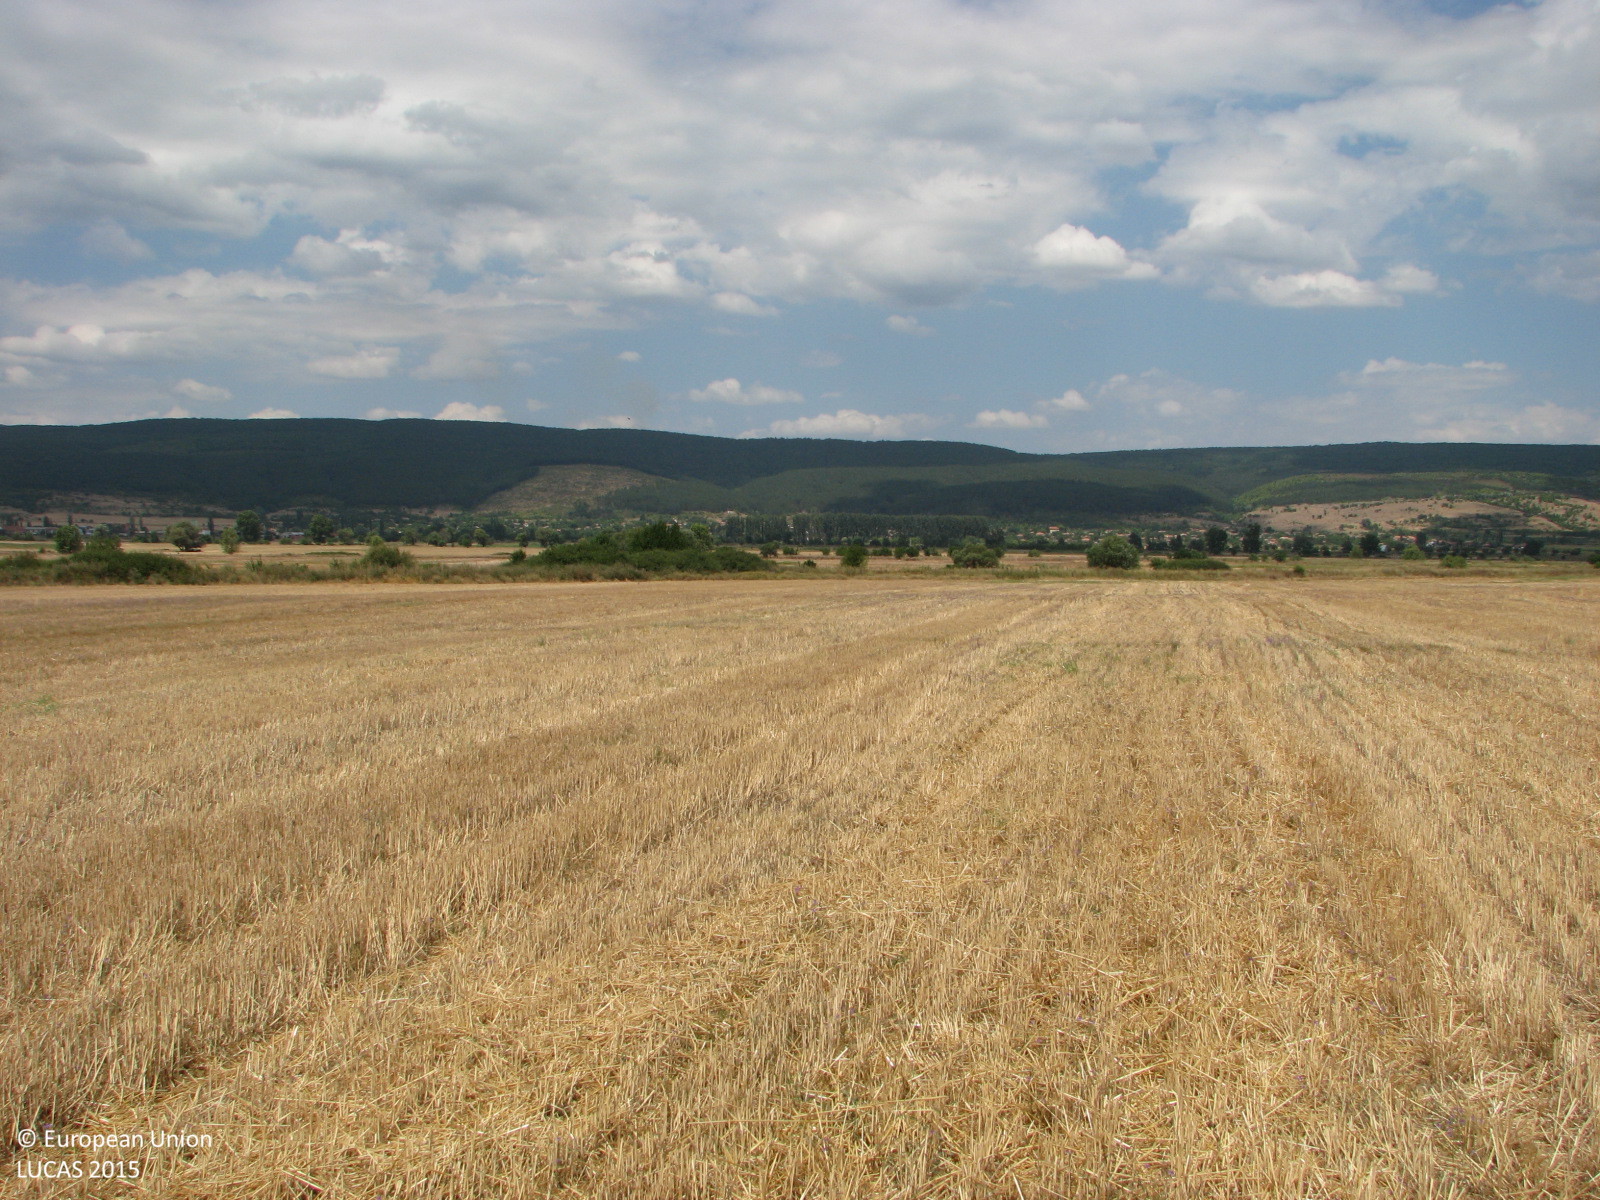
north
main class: Cropland
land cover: Common wheat
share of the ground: 50 - 75 %
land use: Agriculture (excluding fallow land and kitchen gardens)
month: August
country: BG
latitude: 42.7189
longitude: 26.6448
